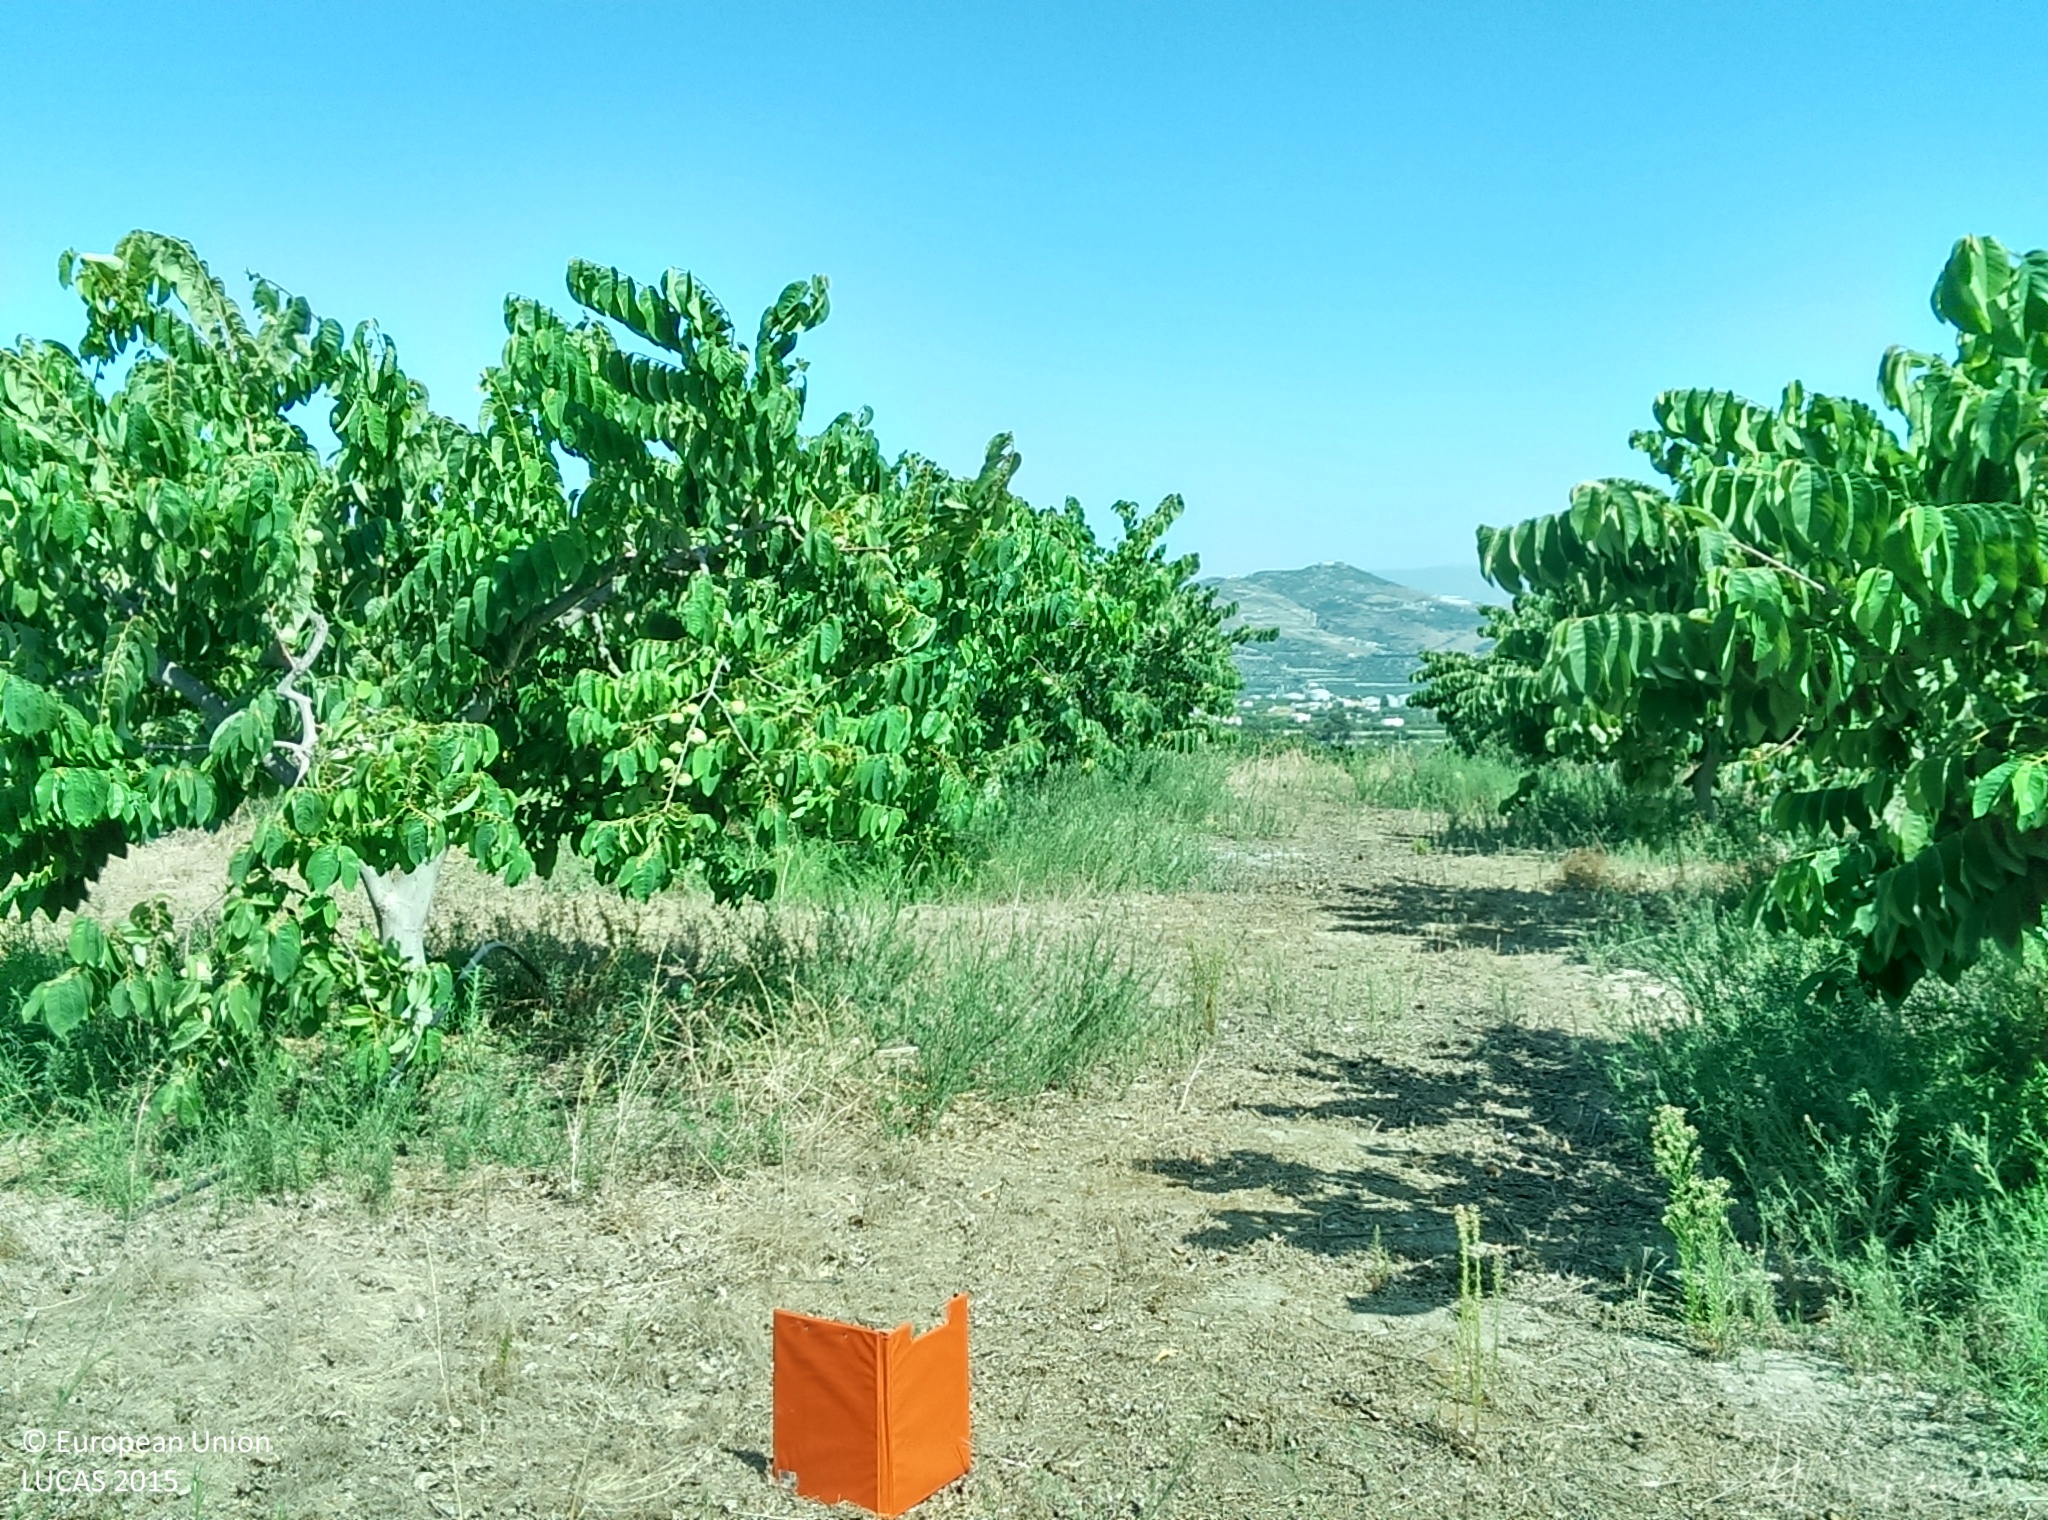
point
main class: Cropland
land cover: Other fruit trees and berries
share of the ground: 50 - 75 %
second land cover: Spontaneously vegetated surfaces
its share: 10 - 25 %
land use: Agriculture (excluding fallow land and kitchen gardens)
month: August
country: ES
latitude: 36.7664
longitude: -3.5939
